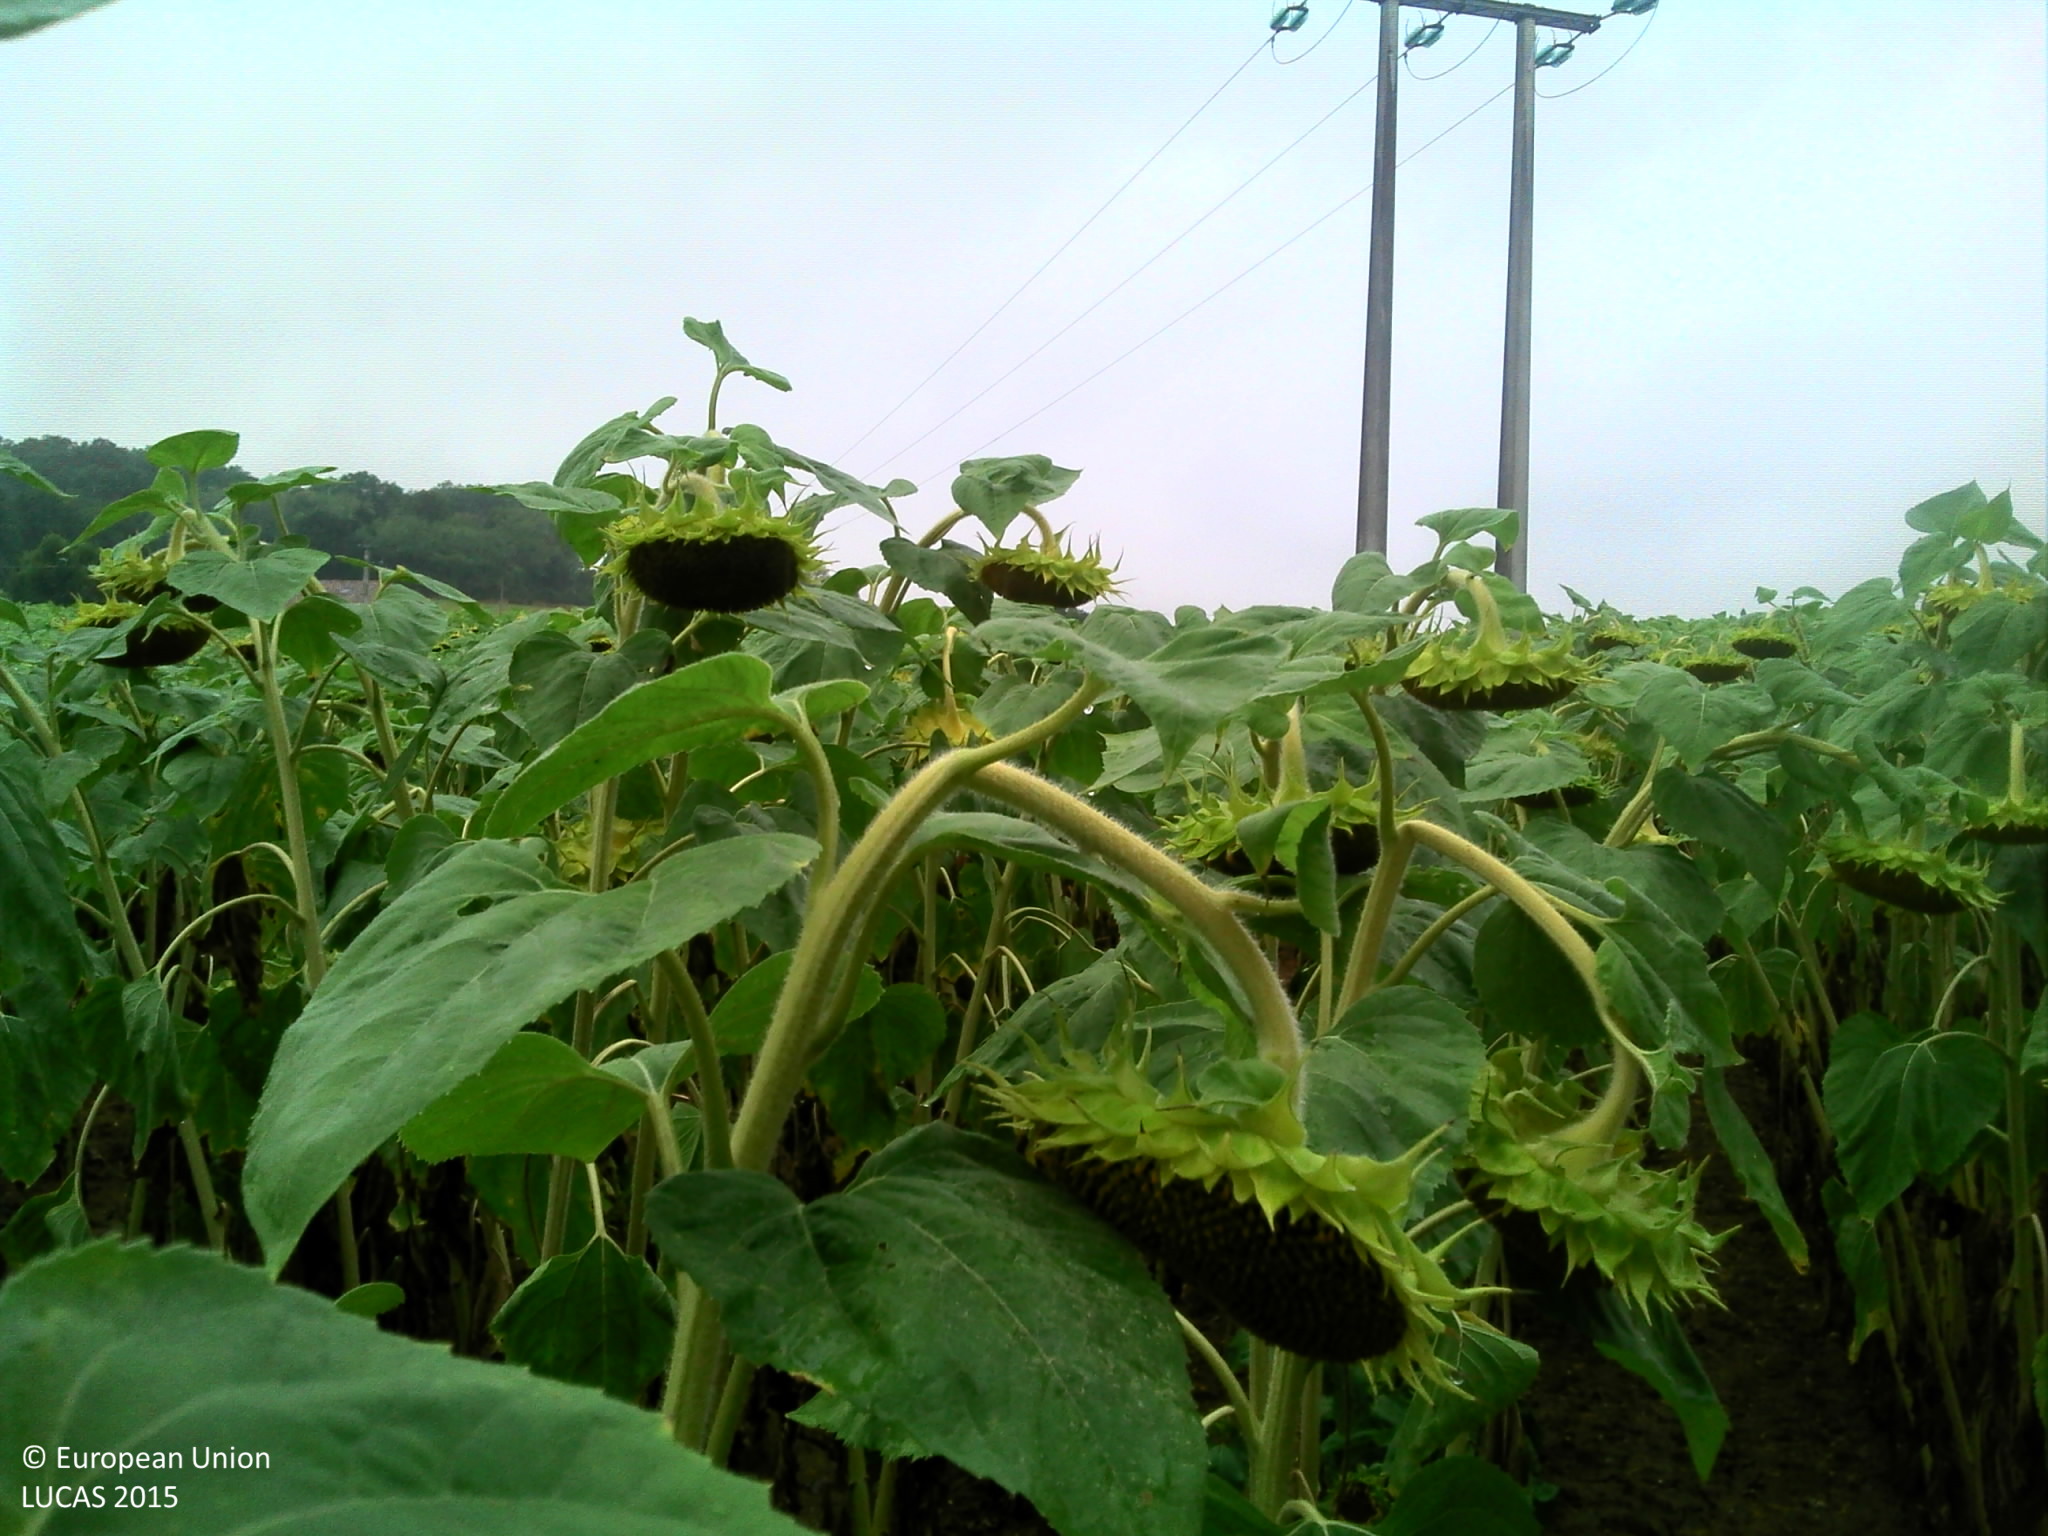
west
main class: Cropland
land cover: Sunflower
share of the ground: > 75 %
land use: Agriculture (excluding fallow land and kitchen gardens)
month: July
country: FR
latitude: 44.3828
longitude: 0.6679
